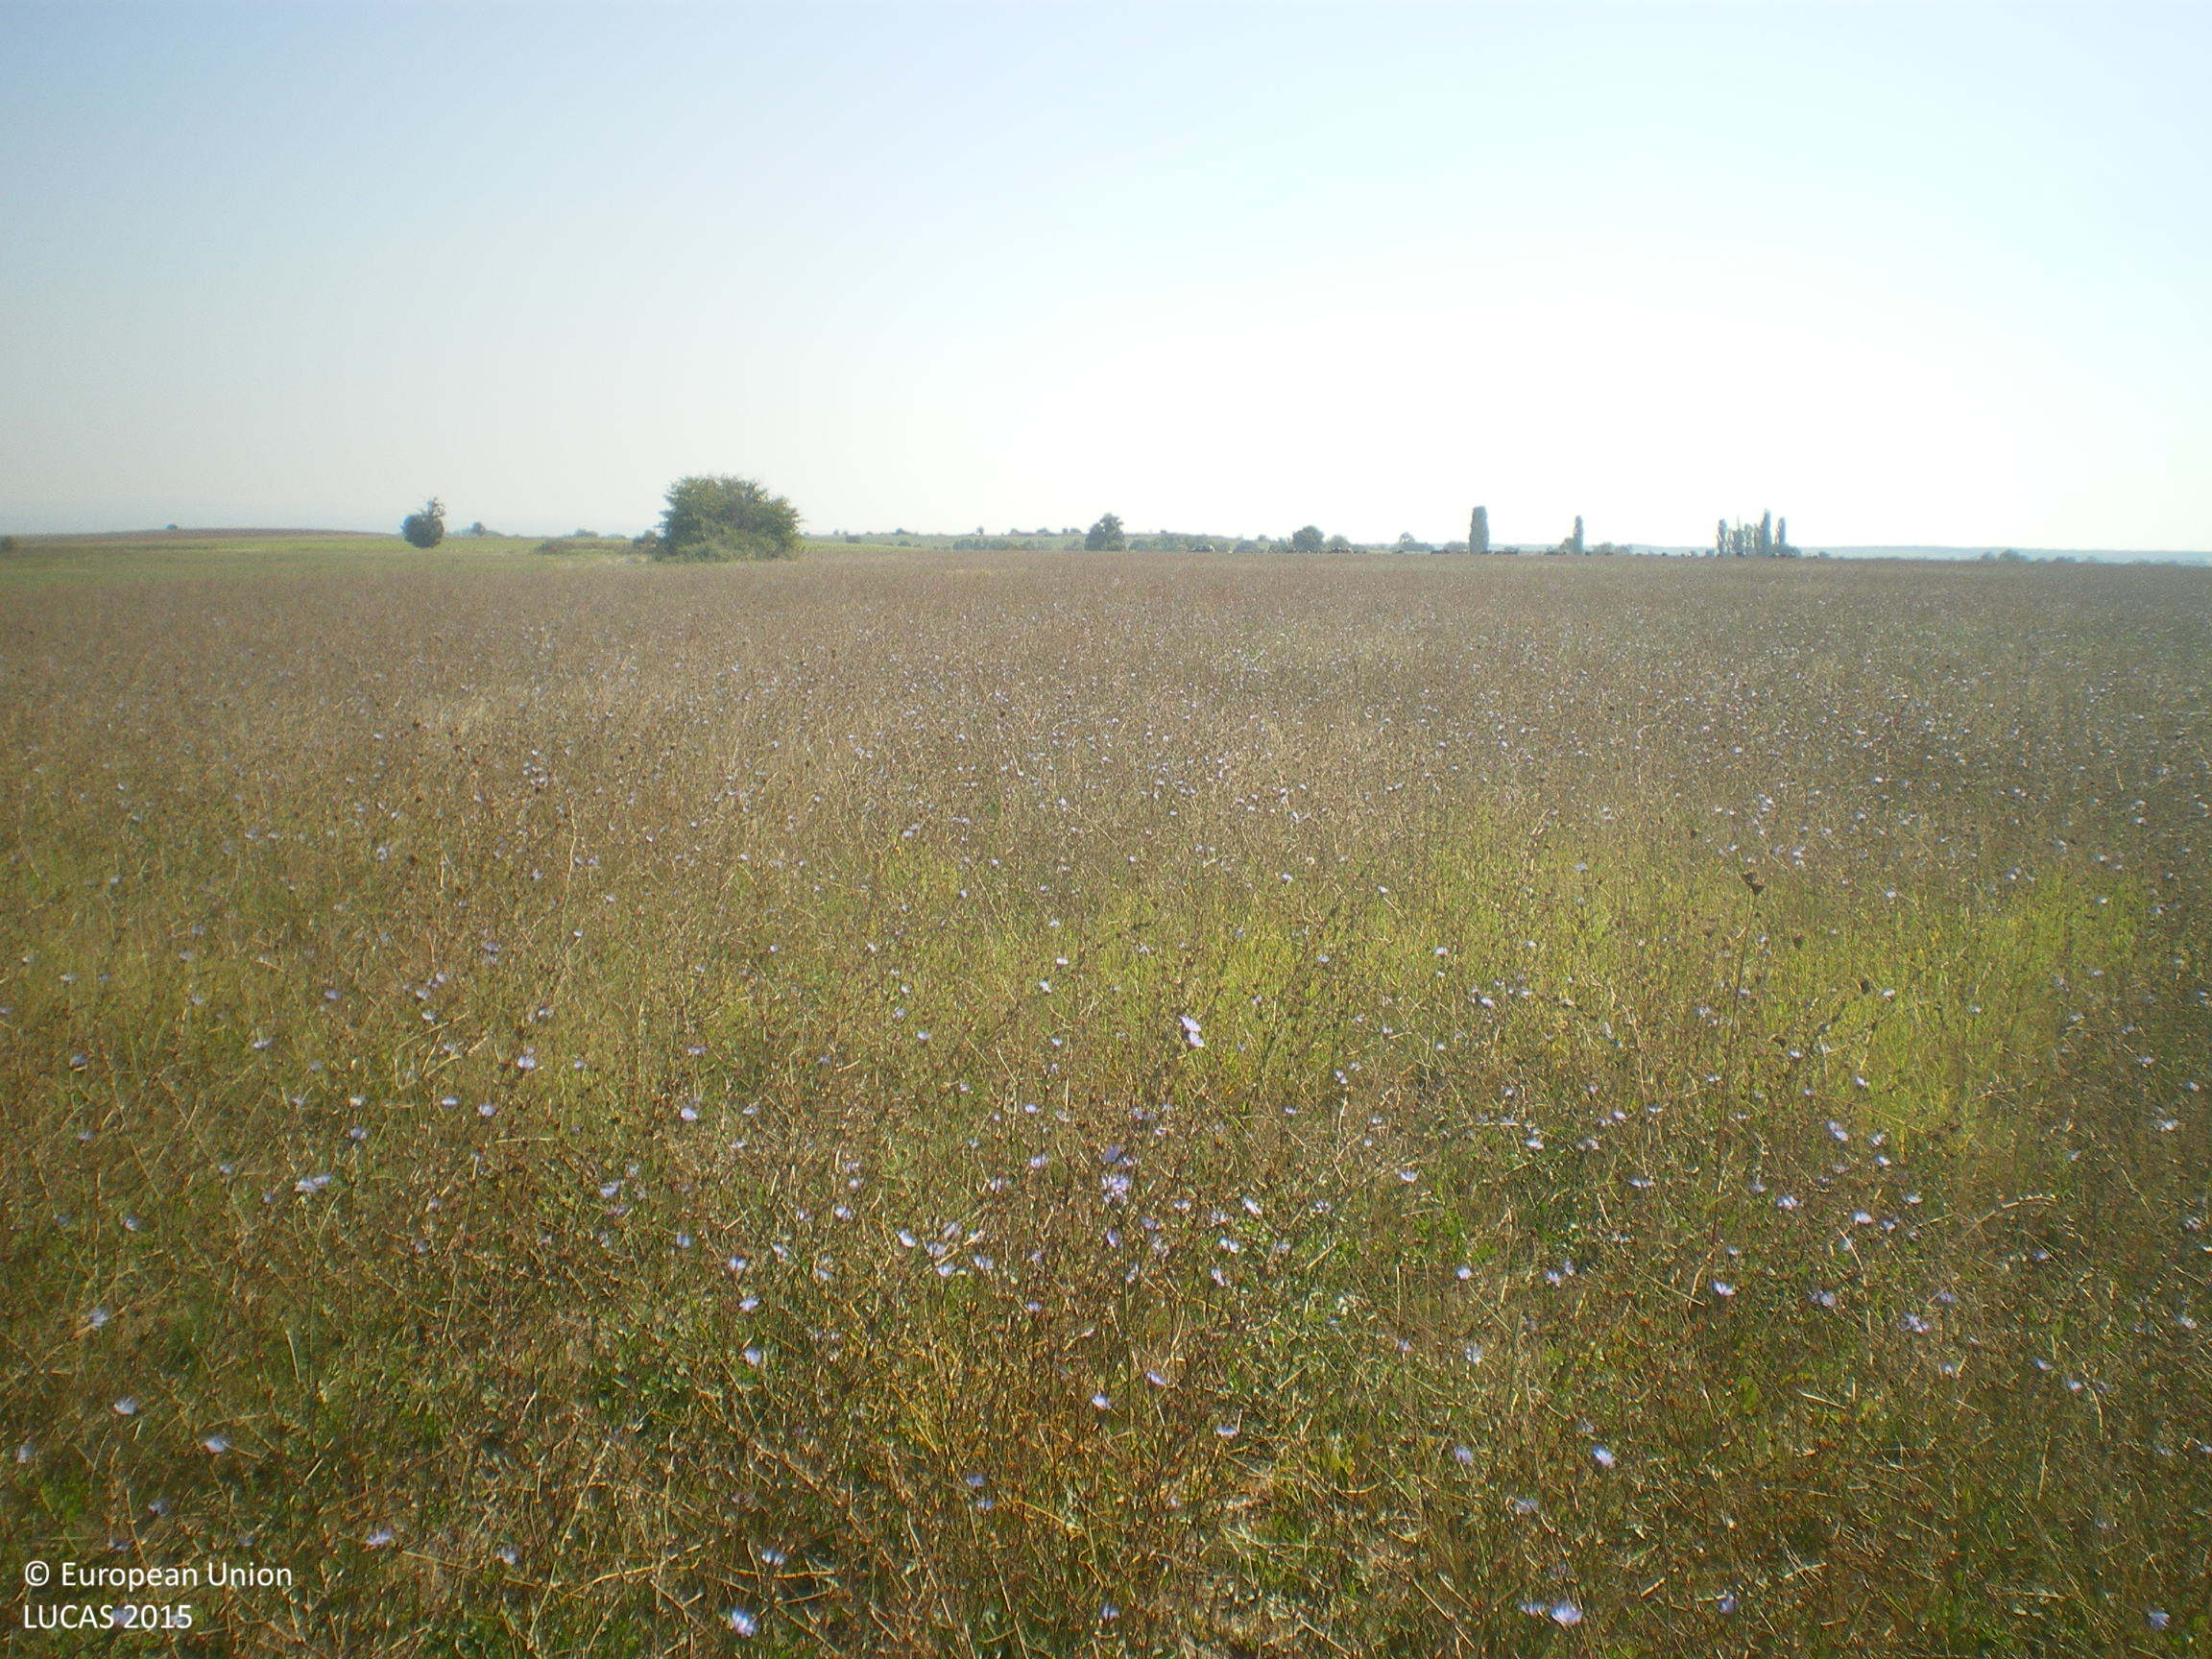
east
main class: Grassland
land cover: Grassland without tree/shrub cover
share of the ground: > 75 %
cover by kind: herbaceous plants 100 %
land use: Agriculture (excluding fallow land and kitchen gardens)
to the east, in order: Grassland without tree/shrub cover
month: September
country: BG
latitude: 41.7786
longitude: 25.9885
